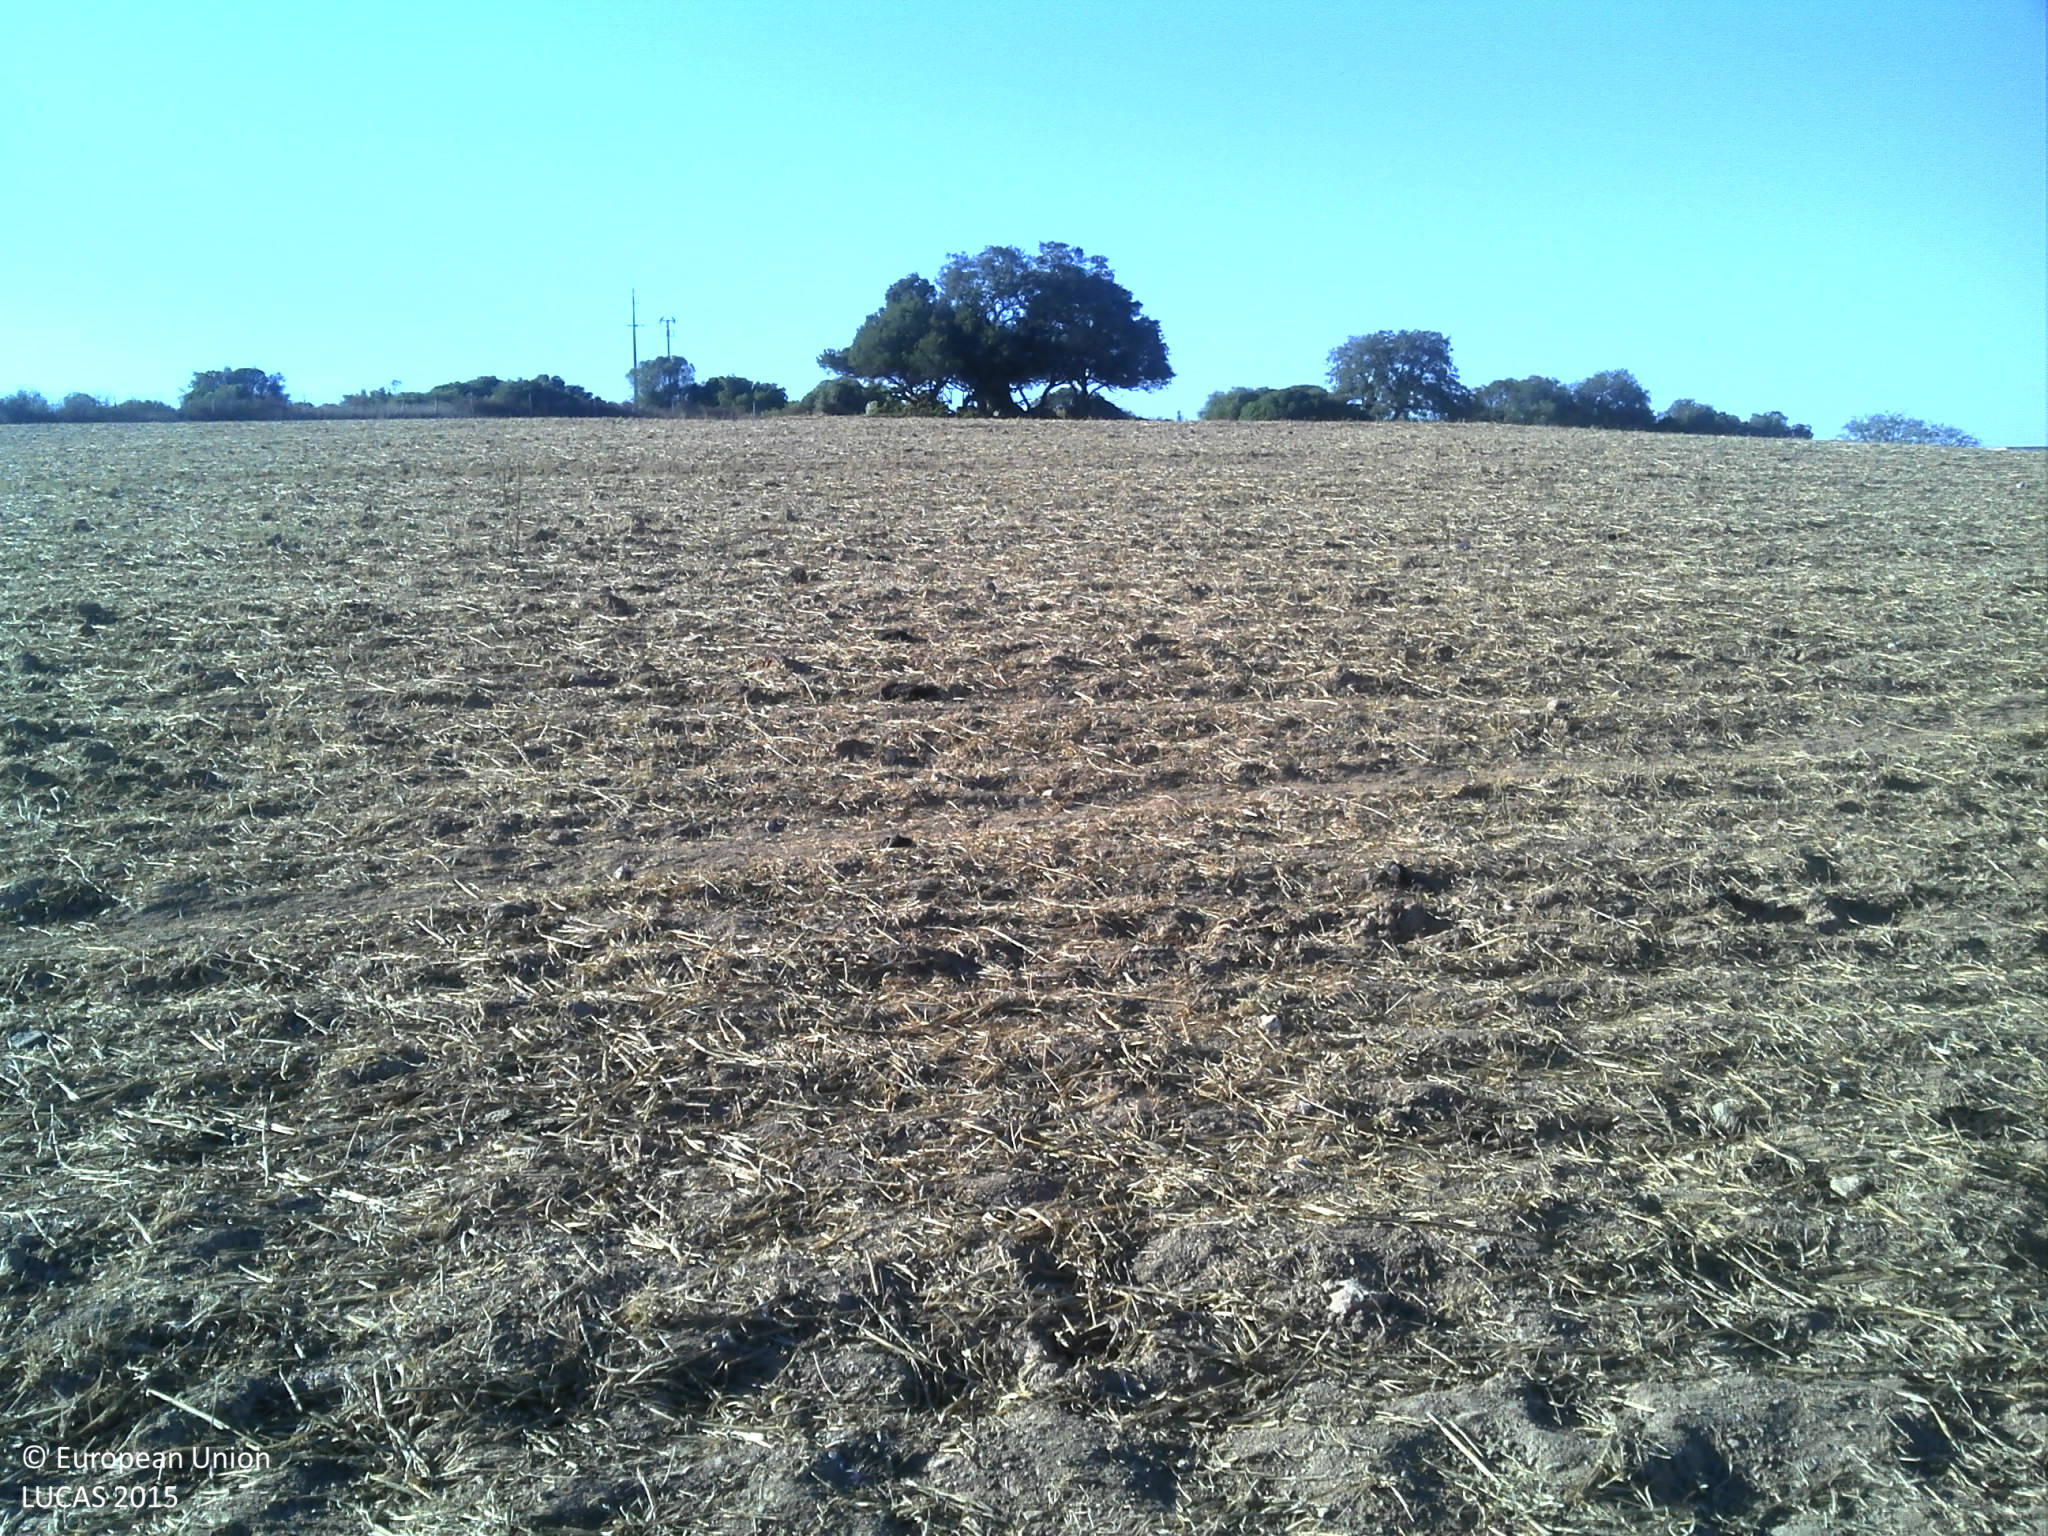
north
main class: Grassland
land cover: Grassland without tree/shrub cover
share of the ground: > 75 %
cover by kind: herbaceous plants 95 %, unconsolidated bare surface 5 %
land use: Agriculture (excluding fallow land and kitchen gardens)
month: July
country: PT
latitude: 37.8792
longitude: -8.0264
